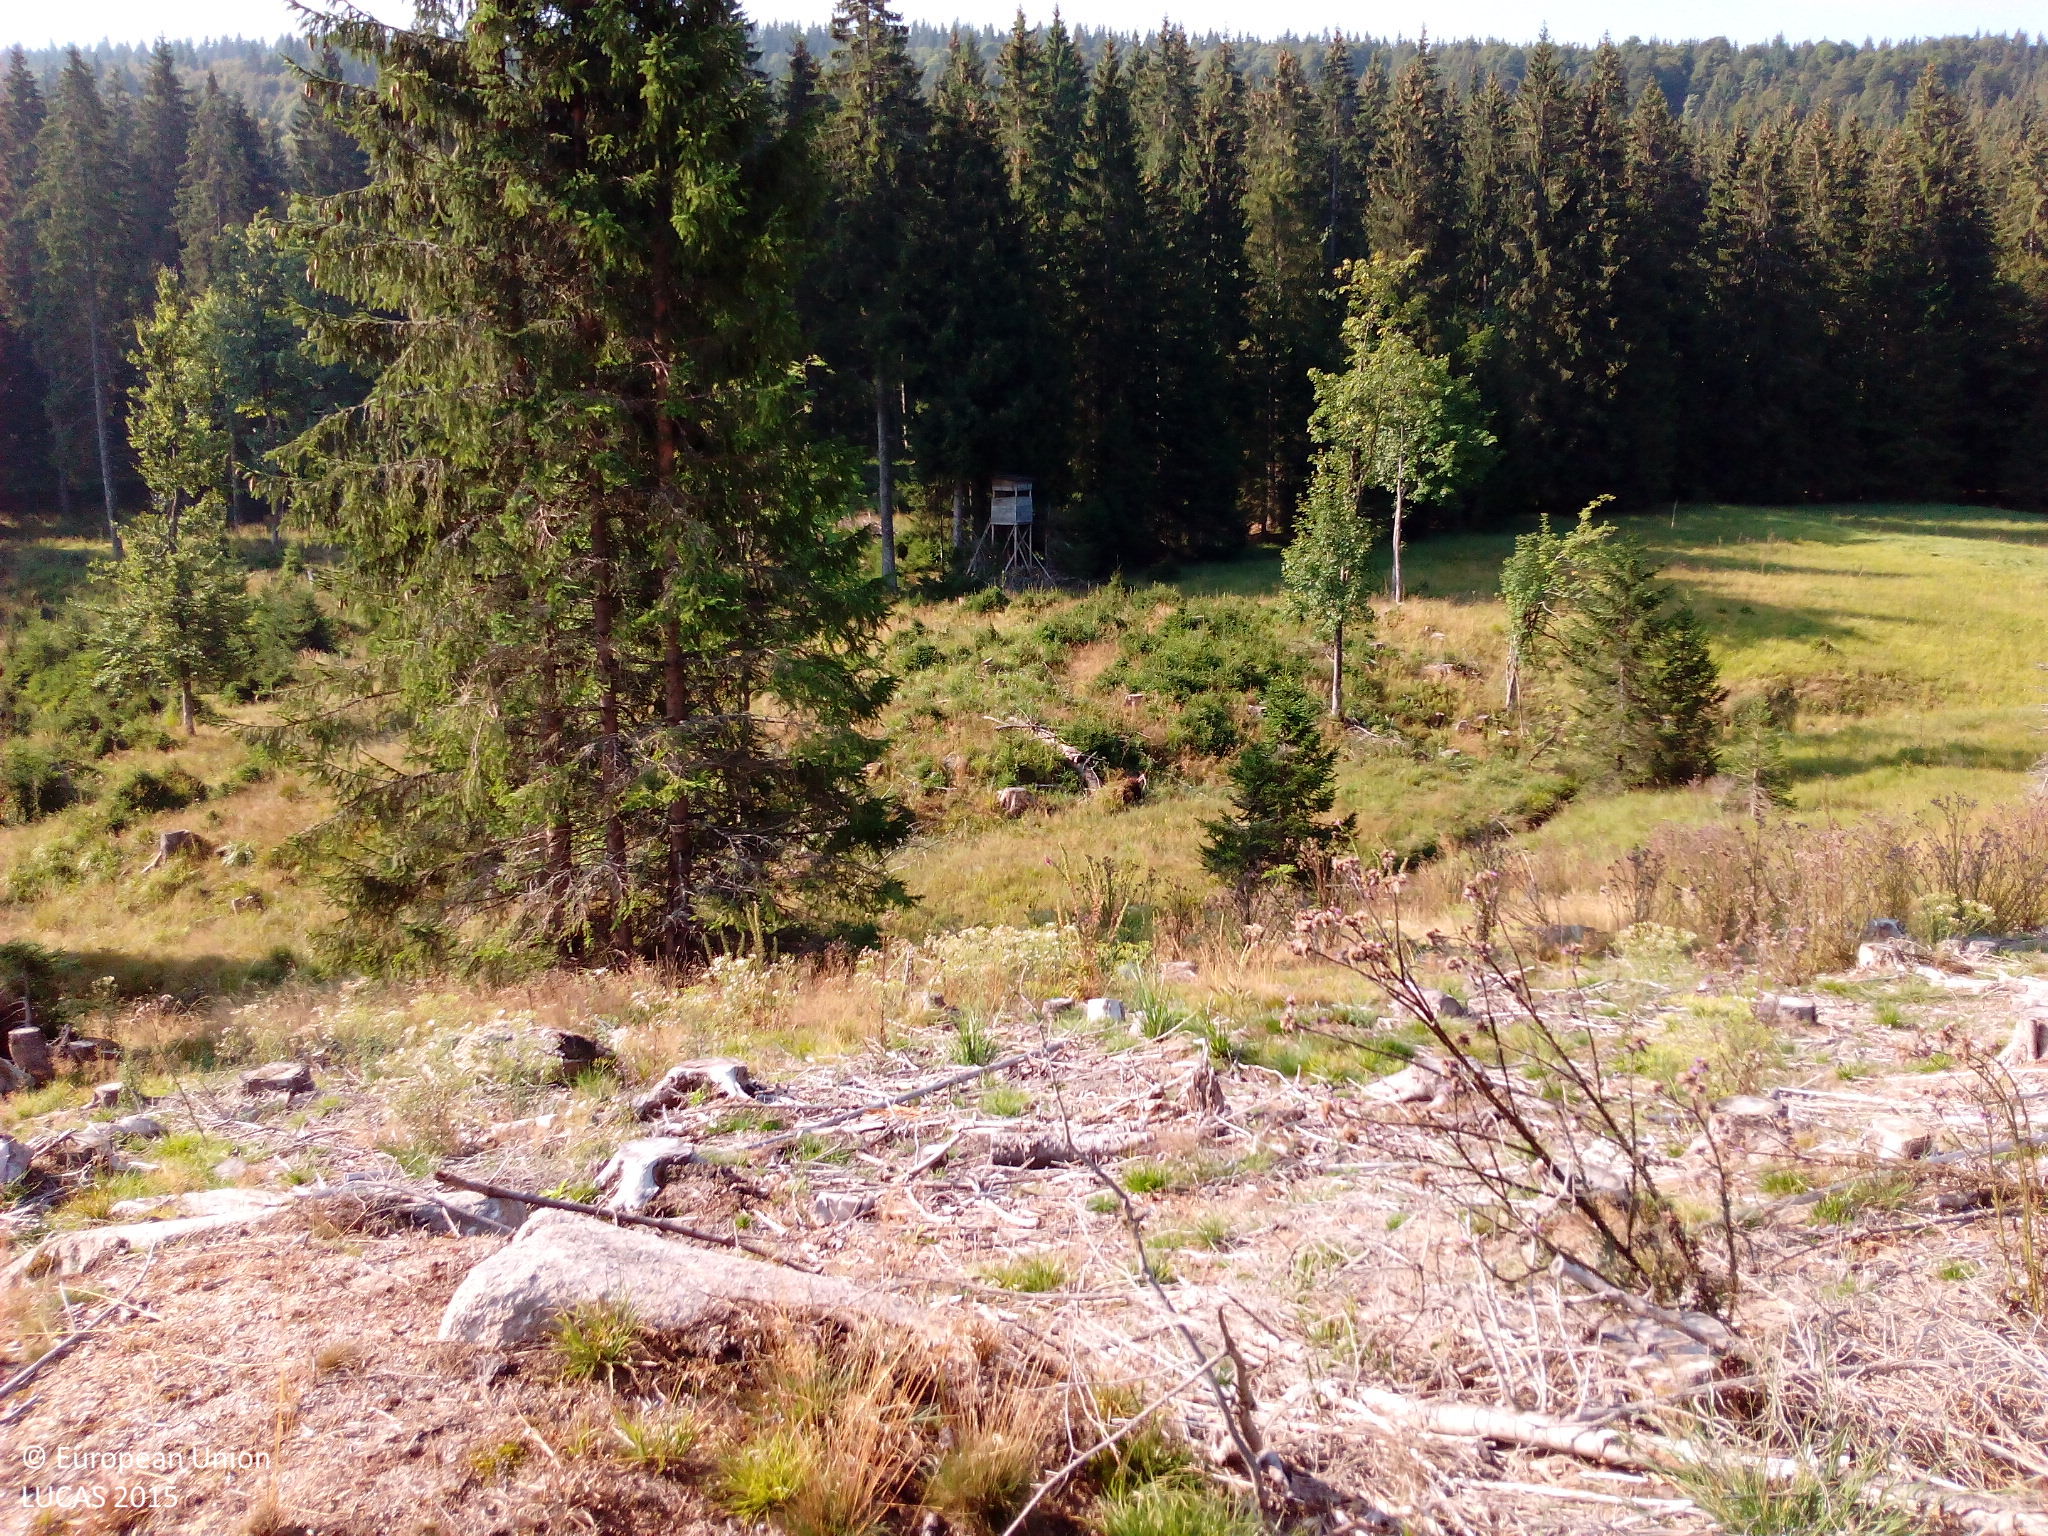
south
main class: Grassland
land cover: Spontaneously vegetated surfaces
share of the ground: 50 - 75 %
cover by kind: herbaceous plants 50 %, unconsolidated bare surface 50 %
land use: Forestry
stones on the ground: 10 - 25 %
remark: Clear cut
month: August
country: DE
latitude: 47.8115
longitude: 8.1183
